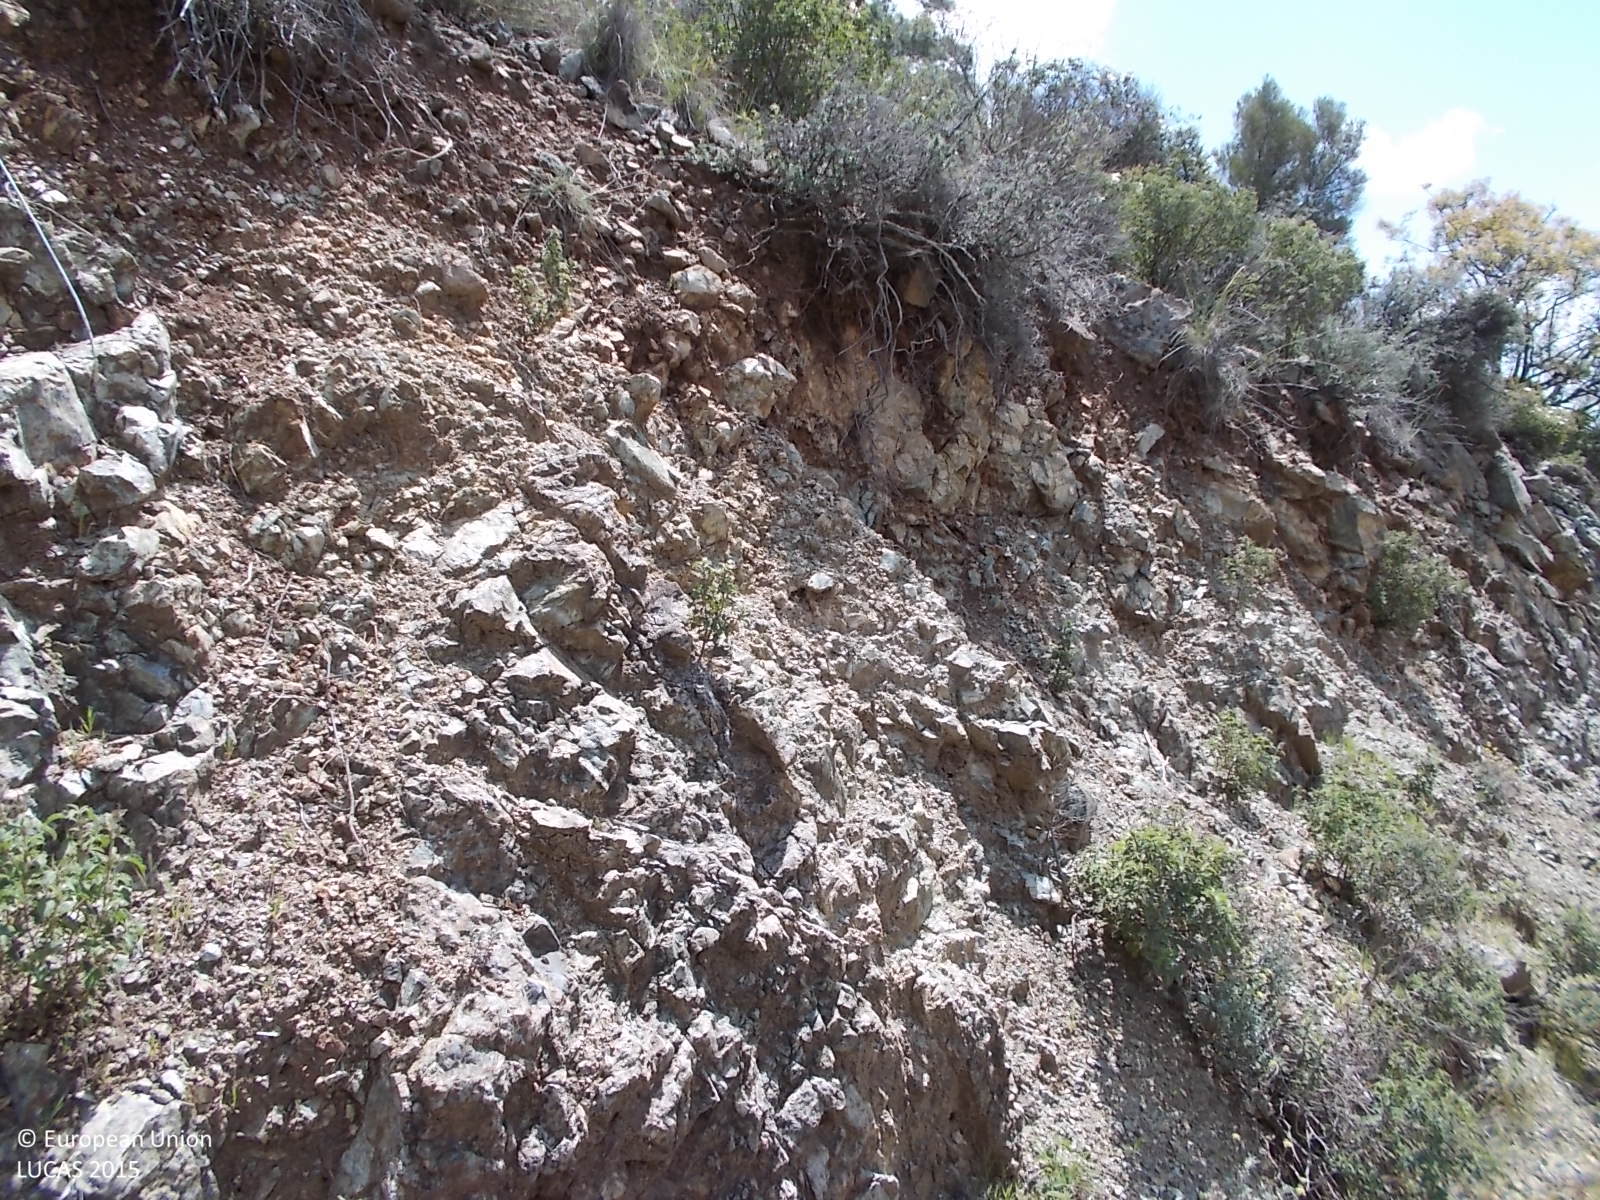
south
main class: Woodland
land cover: Pine dominated coniferous woodland
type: coniferous forest of the mediterranean region
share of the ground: 10 - 25 %
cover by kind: shrubs 50 %, coniferous forest trees 20 %, unconsolidated bare surface 20 %, consolidated bare surface 10 %
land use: Forestry
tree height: > 5 m
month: April
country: CY
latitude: 34.8128
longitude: 33.0728
